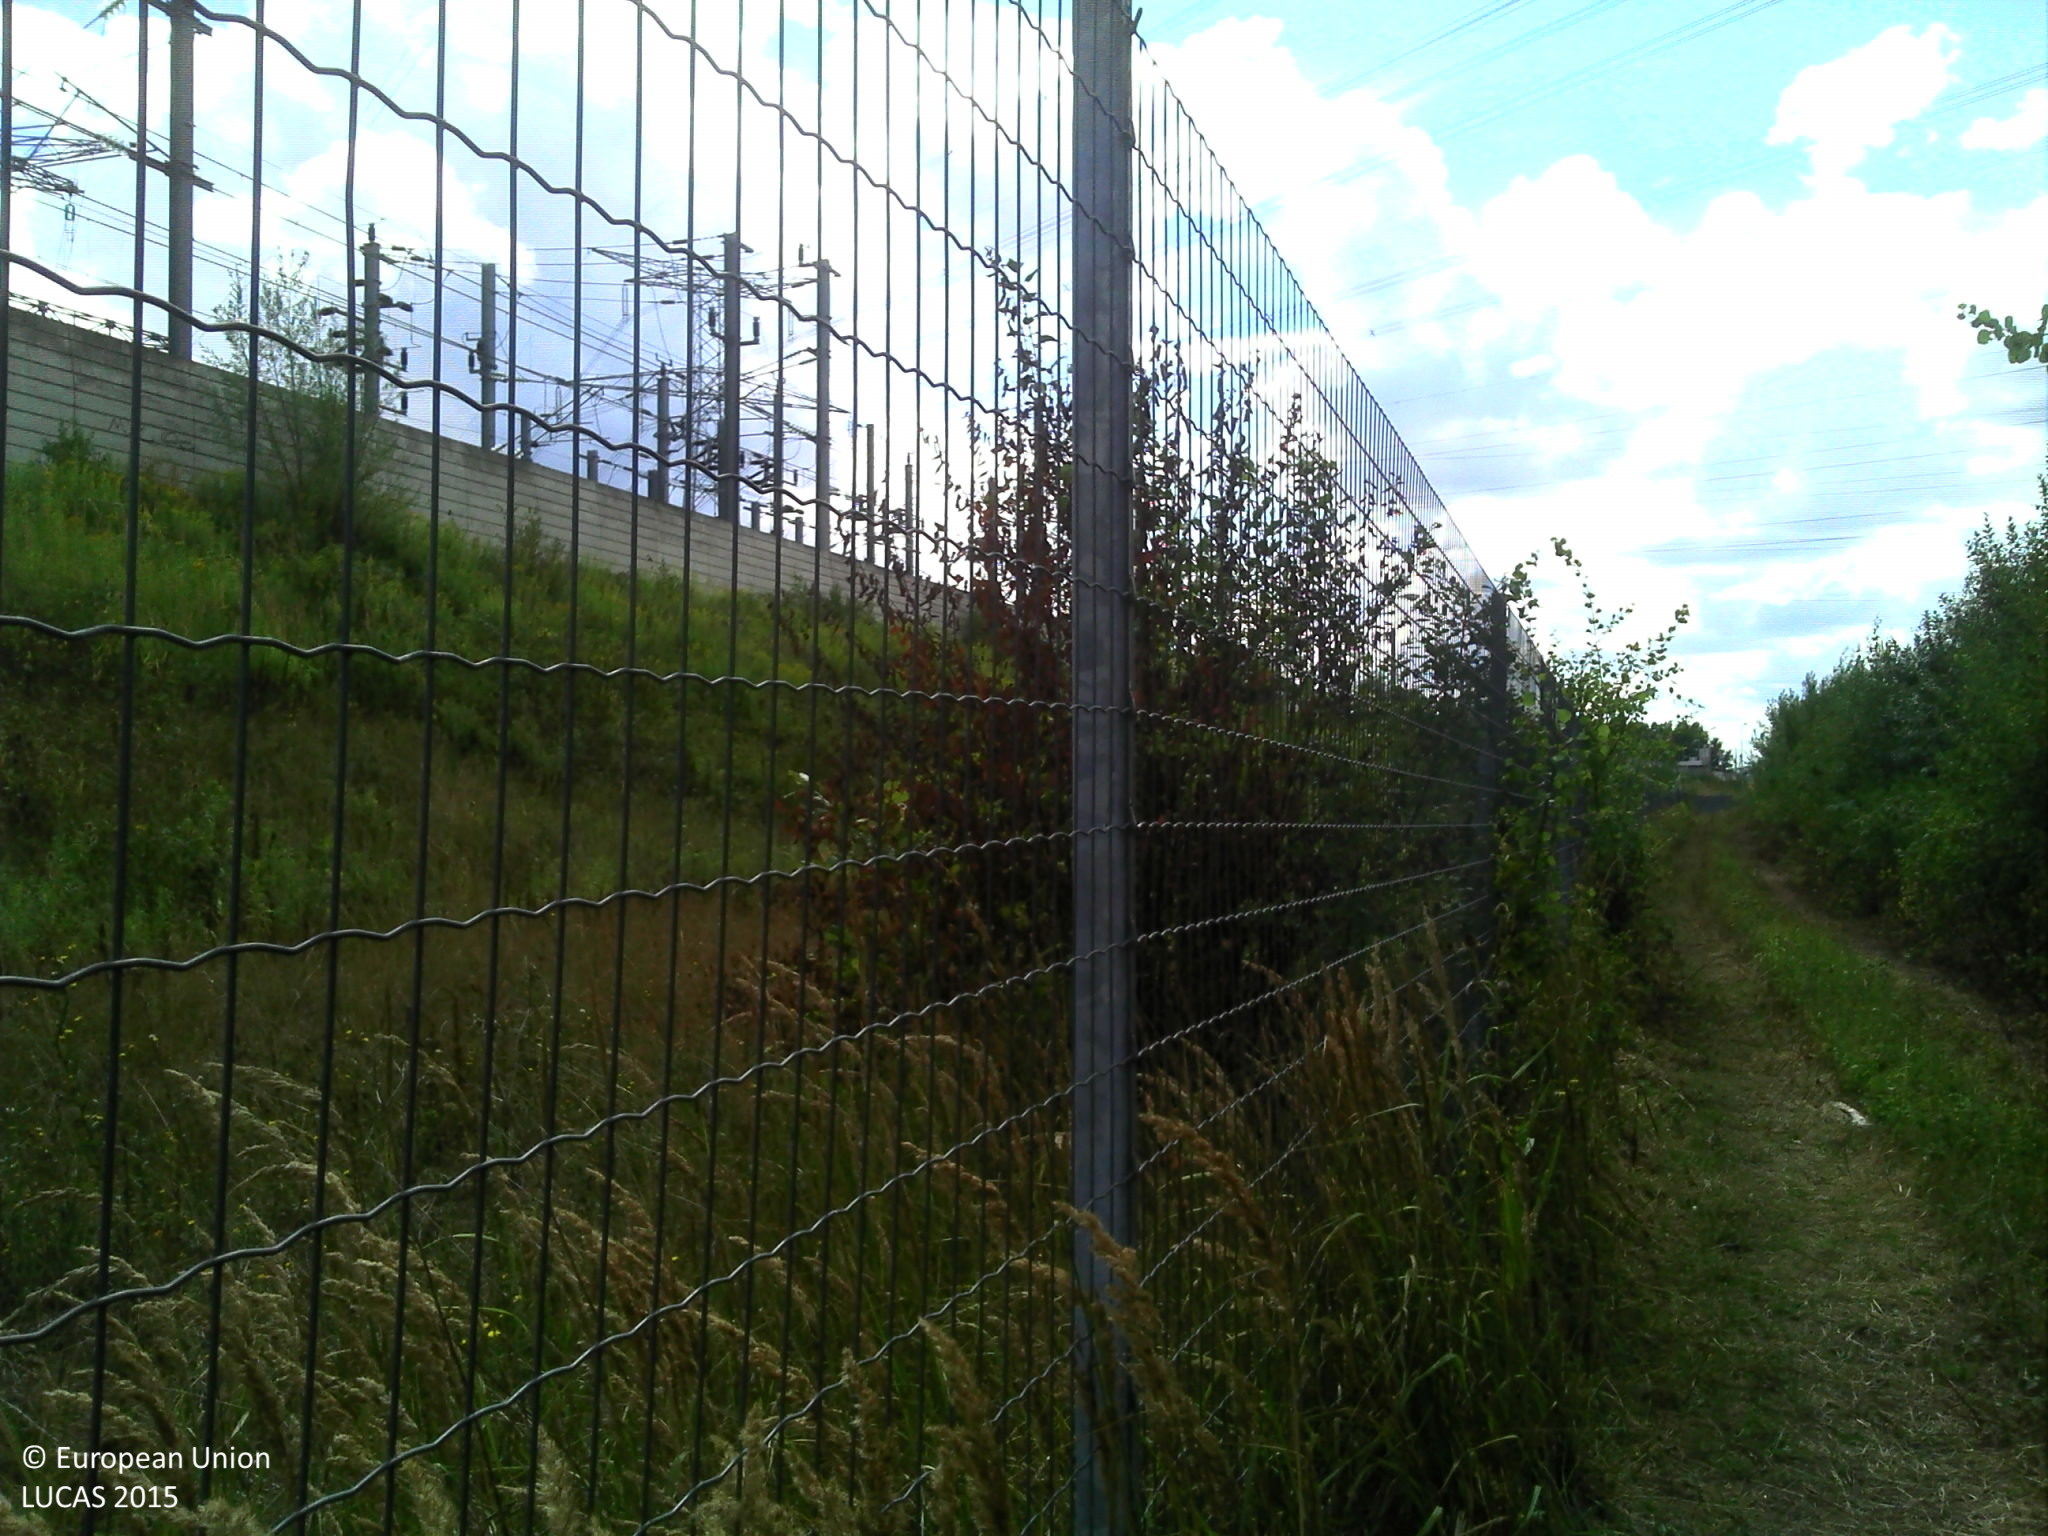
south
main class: Grassland
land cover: Spontaneously vegetated surfaces
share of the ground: > 75 %
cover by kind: herbaceous plants 85 %, lichens and mosses 5 %
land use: Semi-natural and natural areas not in use
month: August
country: FR
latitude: 48.8824
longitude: 2.6667
